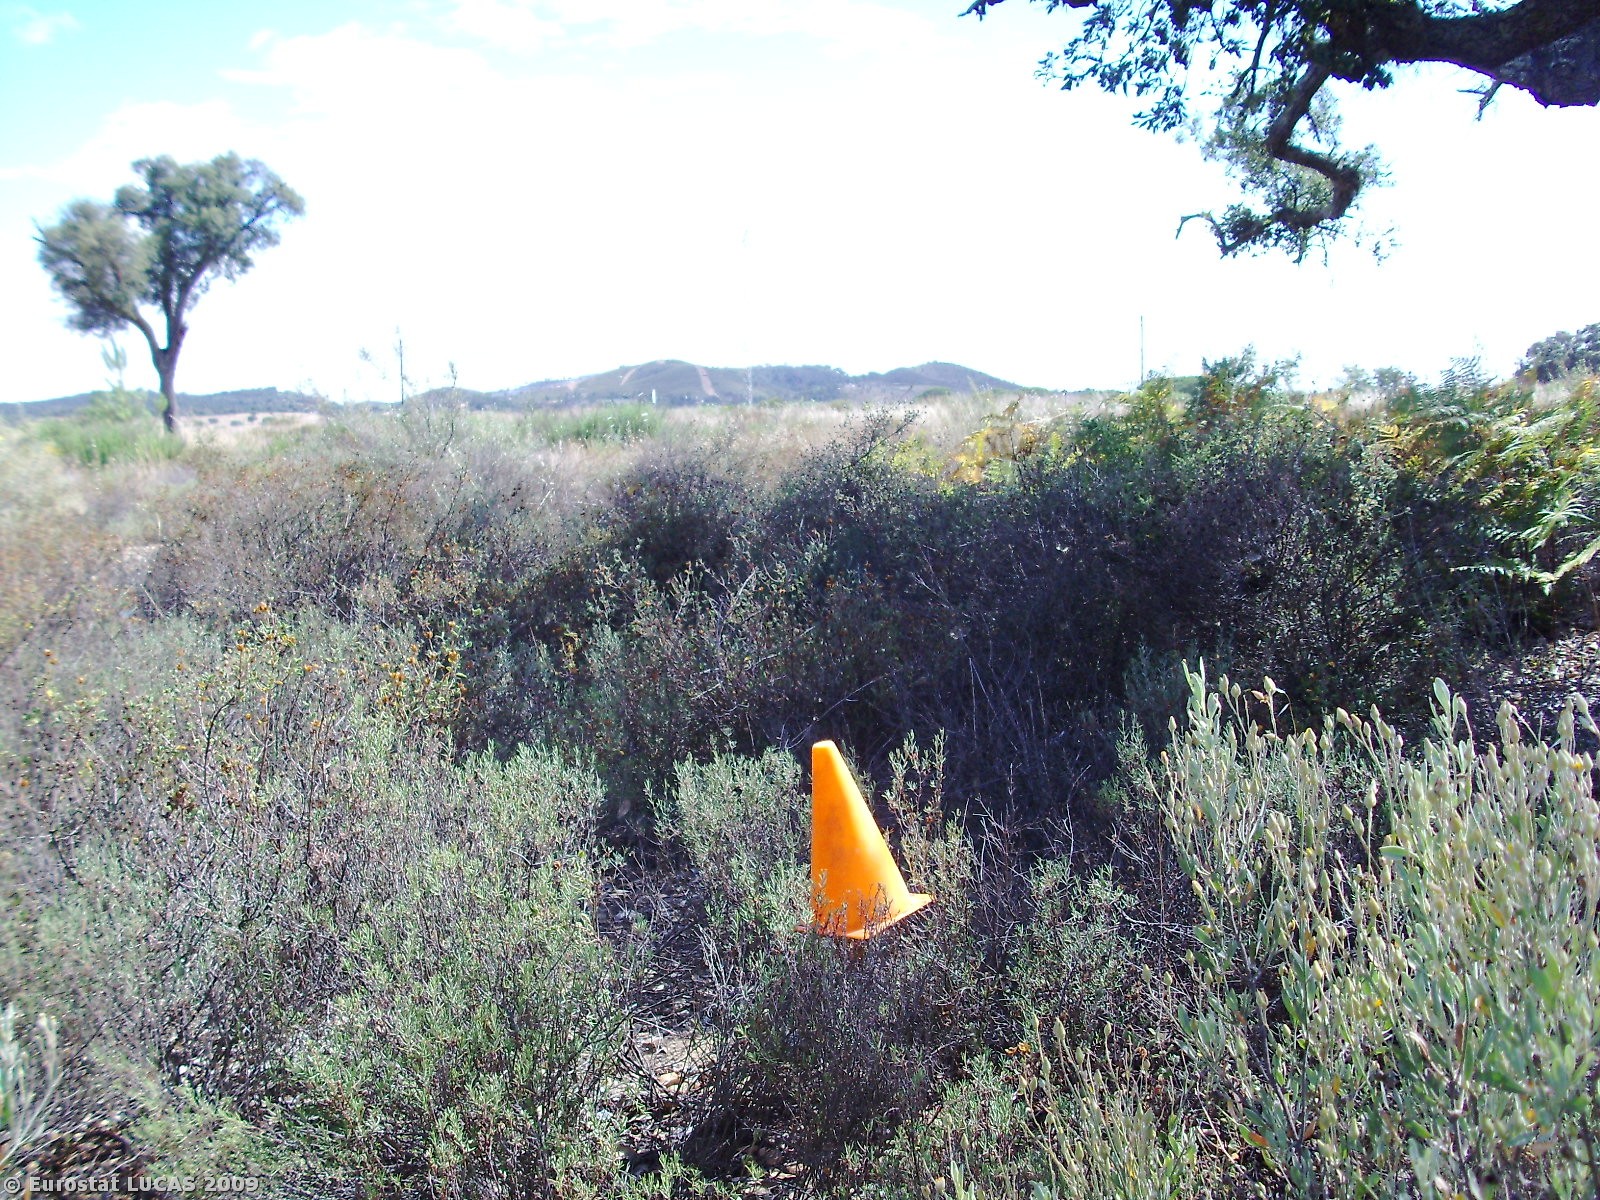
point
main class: Woodland
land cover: Broadleaved woodland
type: broadleaved evergreen forest
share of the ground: 10 - 25 %
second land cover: Shrubland with sparse tree cover
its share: 50 - 75 %
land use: Forestry
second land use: Unused
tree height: > 5 m
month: June
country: PT
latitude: 38.1397
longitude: -8.4952
